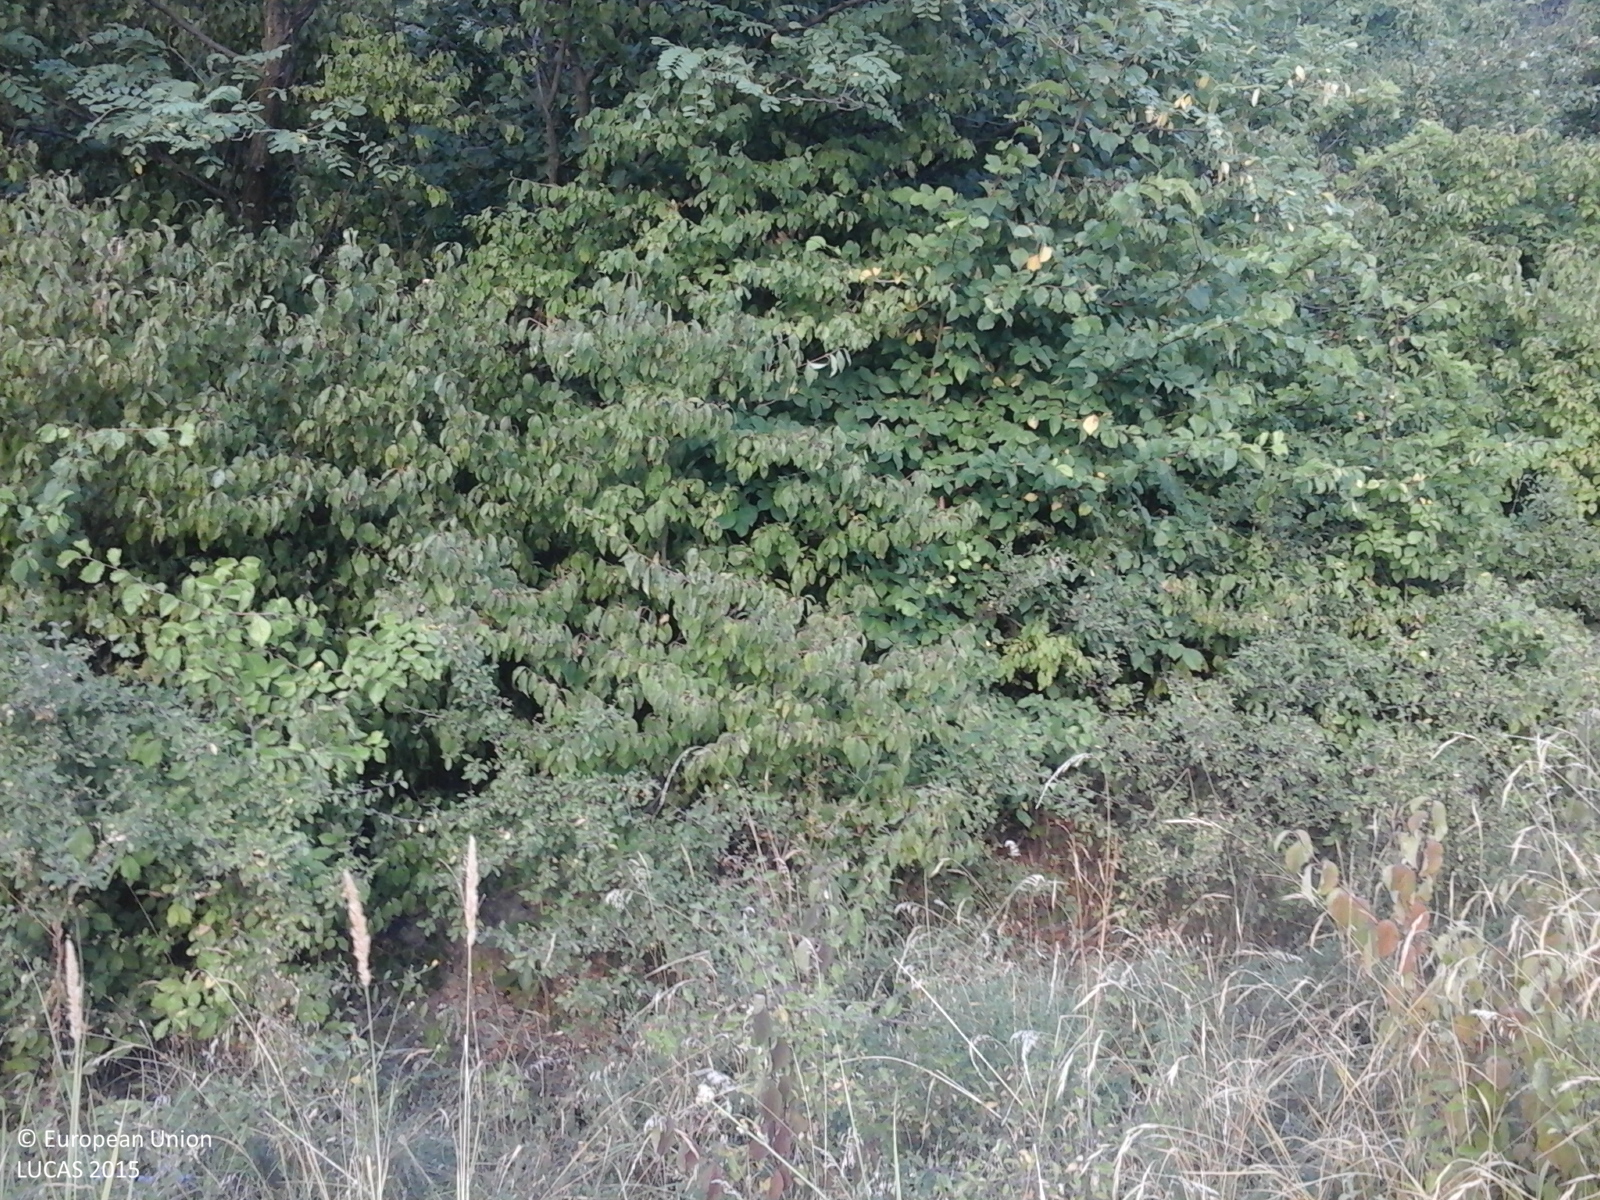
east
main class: Woodland
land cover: Broadleaved woodland
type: mesophytic deciduous forest
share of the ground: > 75 %
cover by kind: broadleaved forest trees 100 %
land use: Forestry
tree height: > 5 m
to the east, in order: Broadleaved woodland; Grassland with sparse tree/shrub cover; Abandoned hedges; Grassland without tree/shrub cover; Broadleaved woodland; Grassland with sparse tree/shrub cover
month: August
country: RO
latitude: 44.5655
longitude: 23.0278
